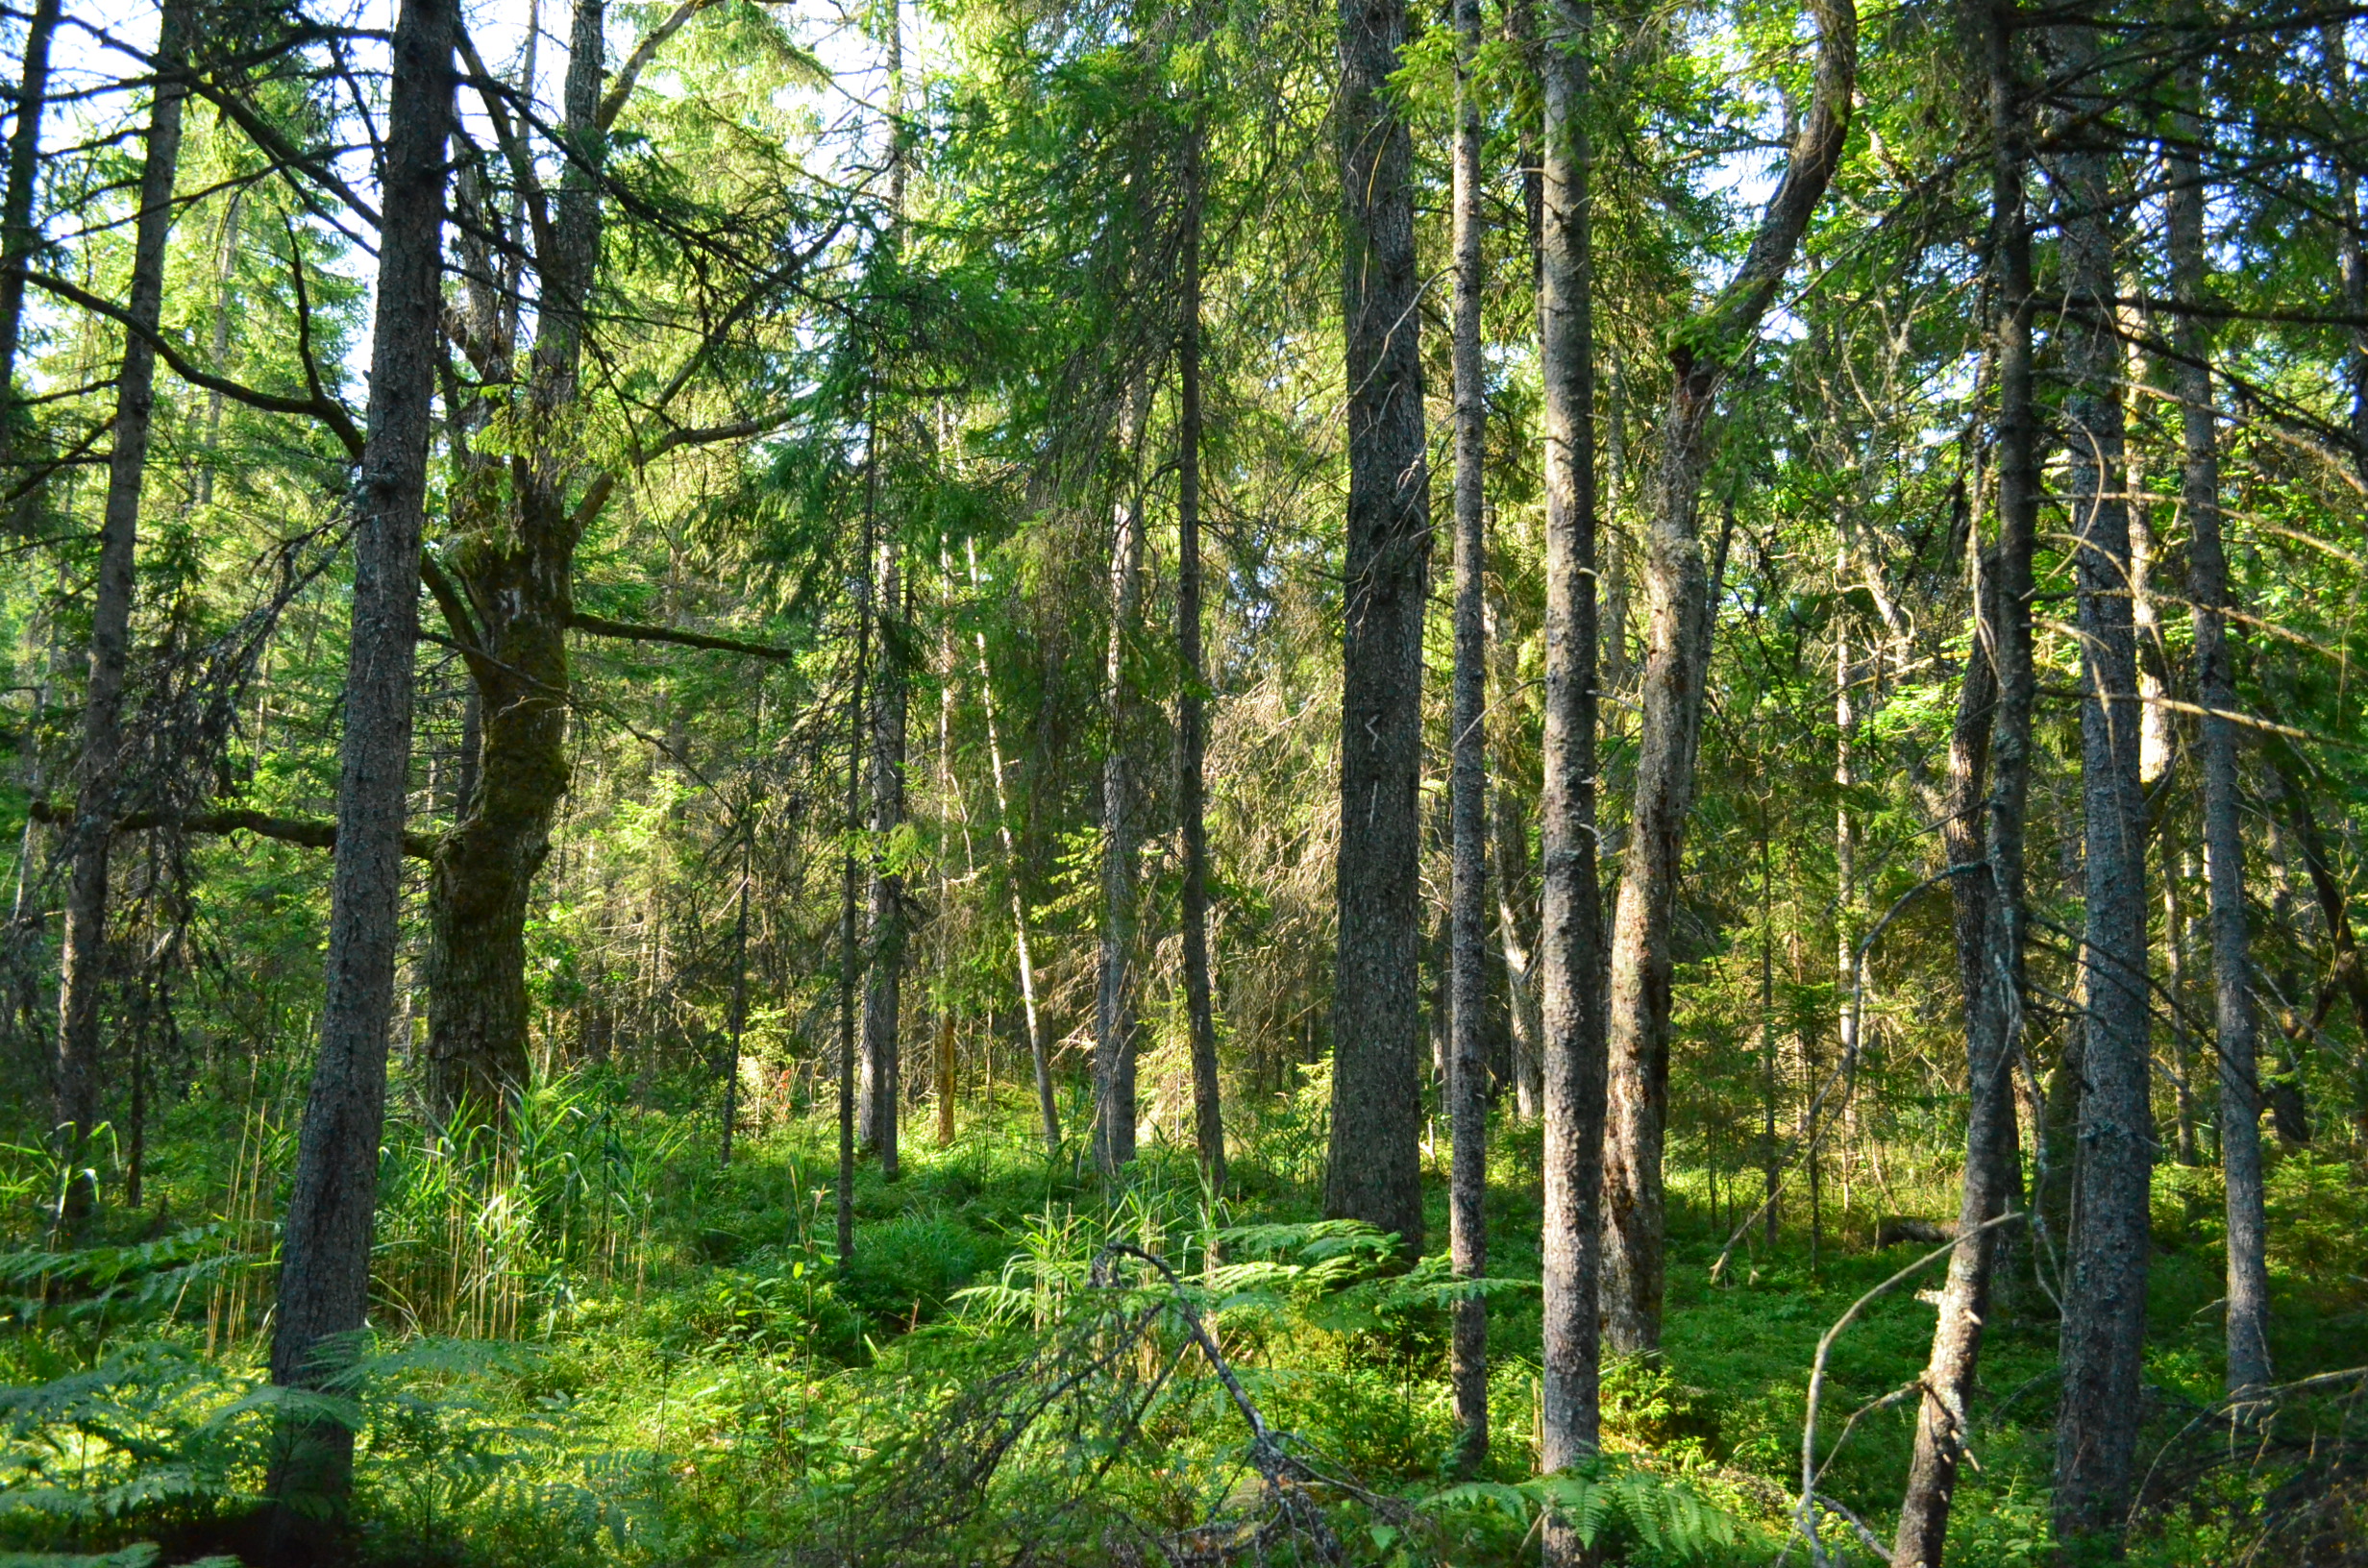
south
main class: Woodland
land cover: Spruce dominated coniferous woodland
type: hemiboreal forest and nemoral coniferous forest and mixed broadleaved-coniferous forest
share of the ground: 50 - 75 %
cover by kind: coniferous forest trees 60 %, shrubs 15 %, herbaceous plants 10 %, lichens and mosses 10 %, broadleaved forest trees 5 %
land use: Forestry
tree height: > 5 m
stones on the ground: < 10 %
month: August
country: LV
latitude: 57.6375
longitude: 22.2592
